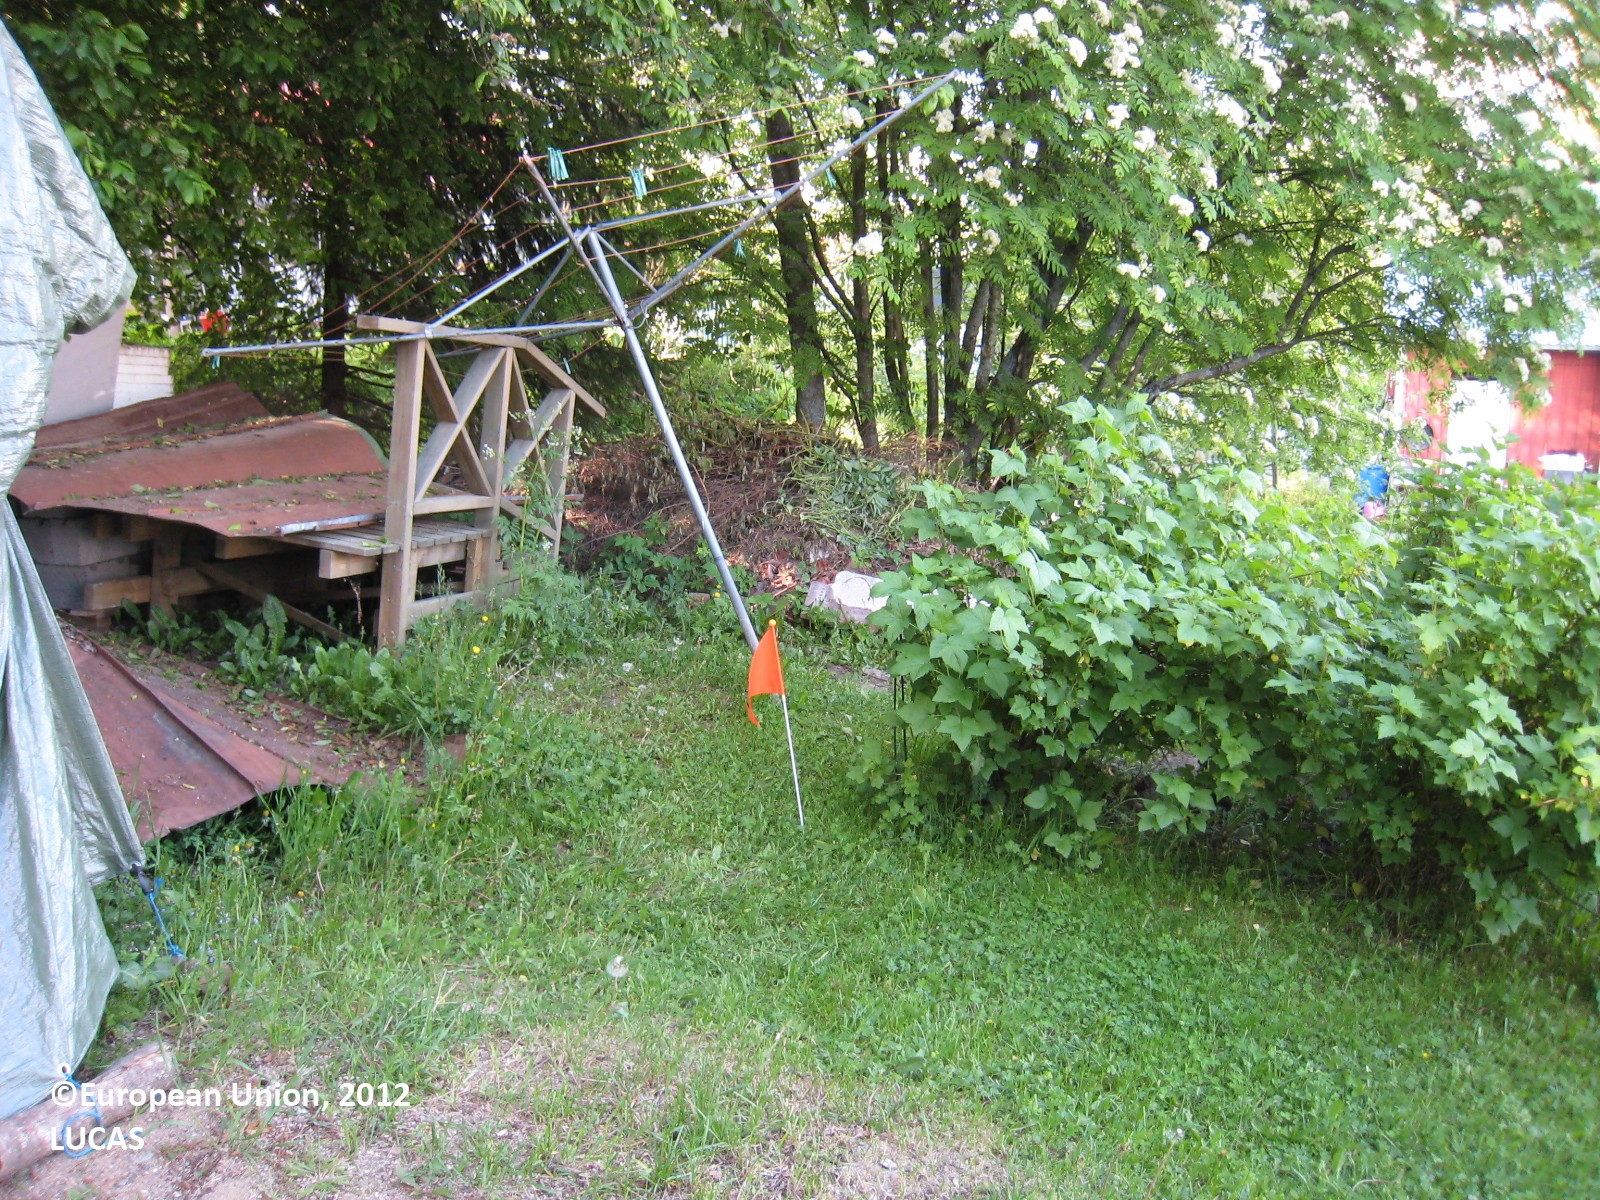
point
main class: Grassland
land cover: Grassland with sparse tree/shrub cover
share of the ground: > 75 %
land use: Residential
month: June
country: FI
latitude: 62.2448
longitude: 25.8487
